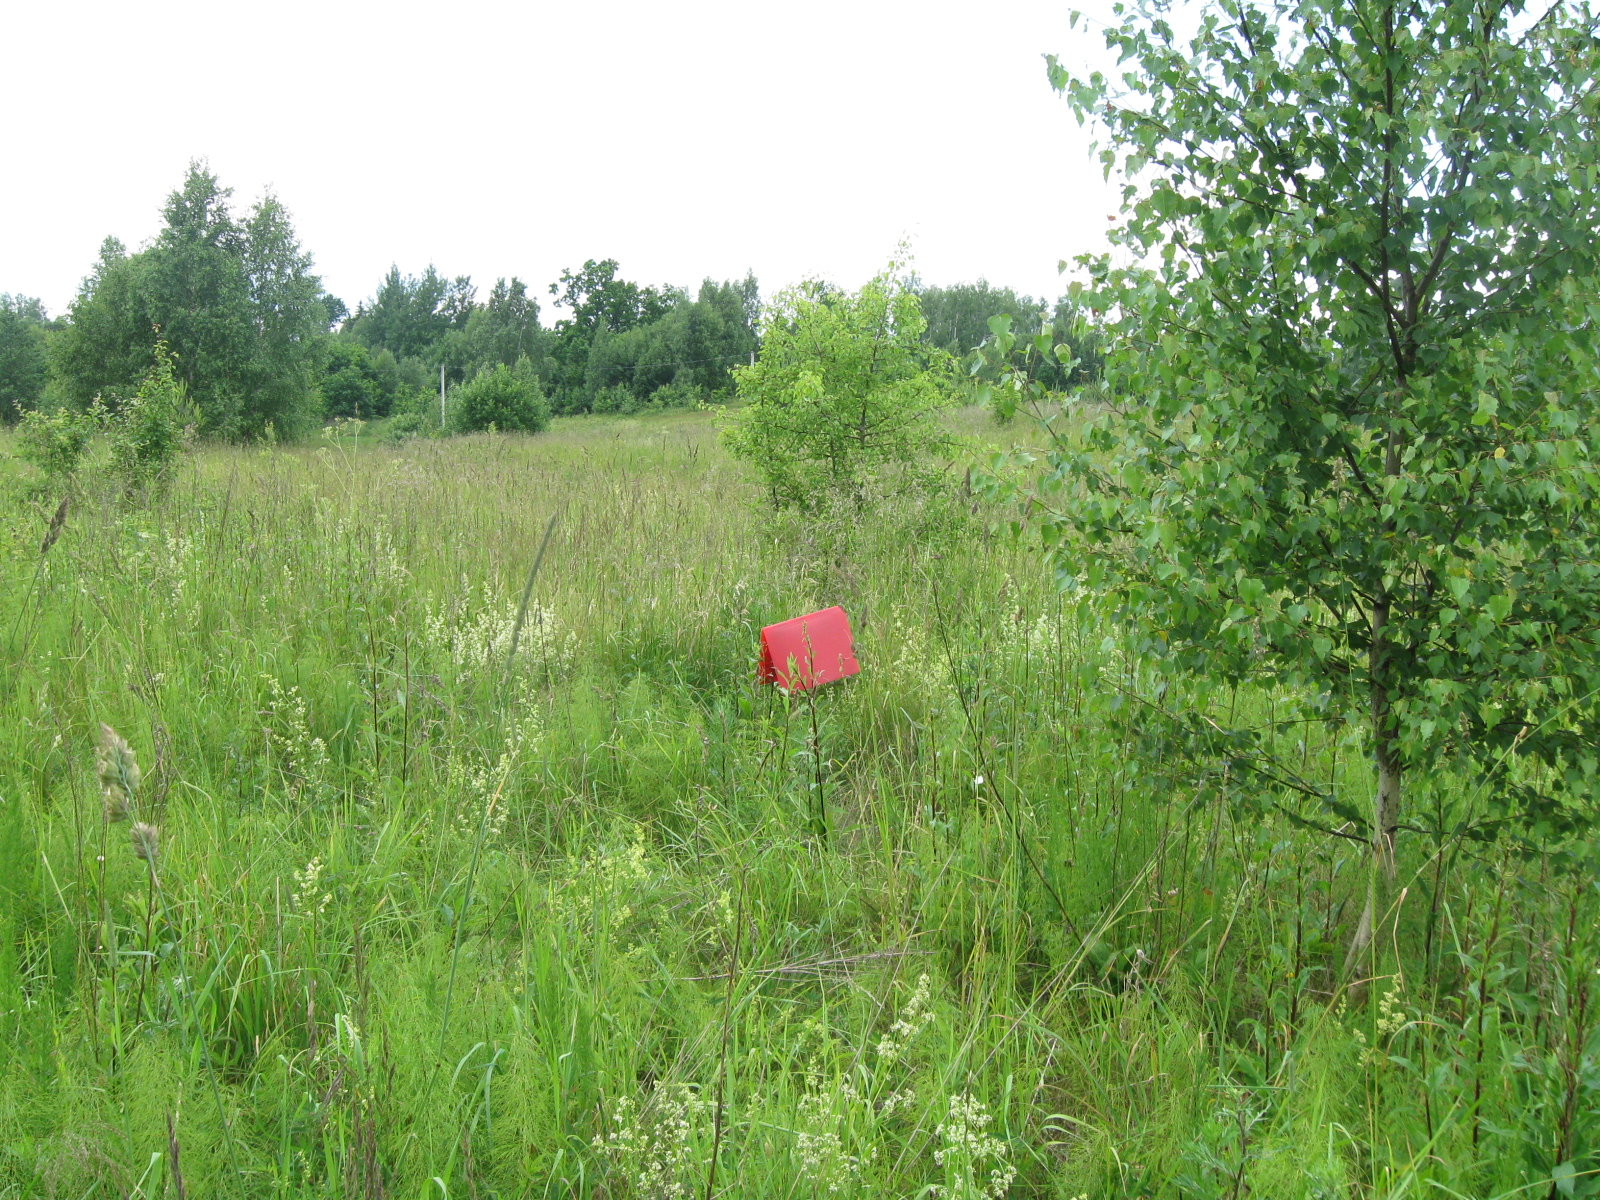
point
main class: Grassland
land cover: Grassland with sparse tree/shrub cover
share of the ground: > 75 %
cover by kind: herbaceous plants 90 %, broadleaved forest trees 5 %, shrubs 5 %
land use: Agriculture (excluding fallow land and kitchen gardens)
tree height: < 5 m
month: June
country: LT
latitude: 54.5076
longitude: 24.4180
